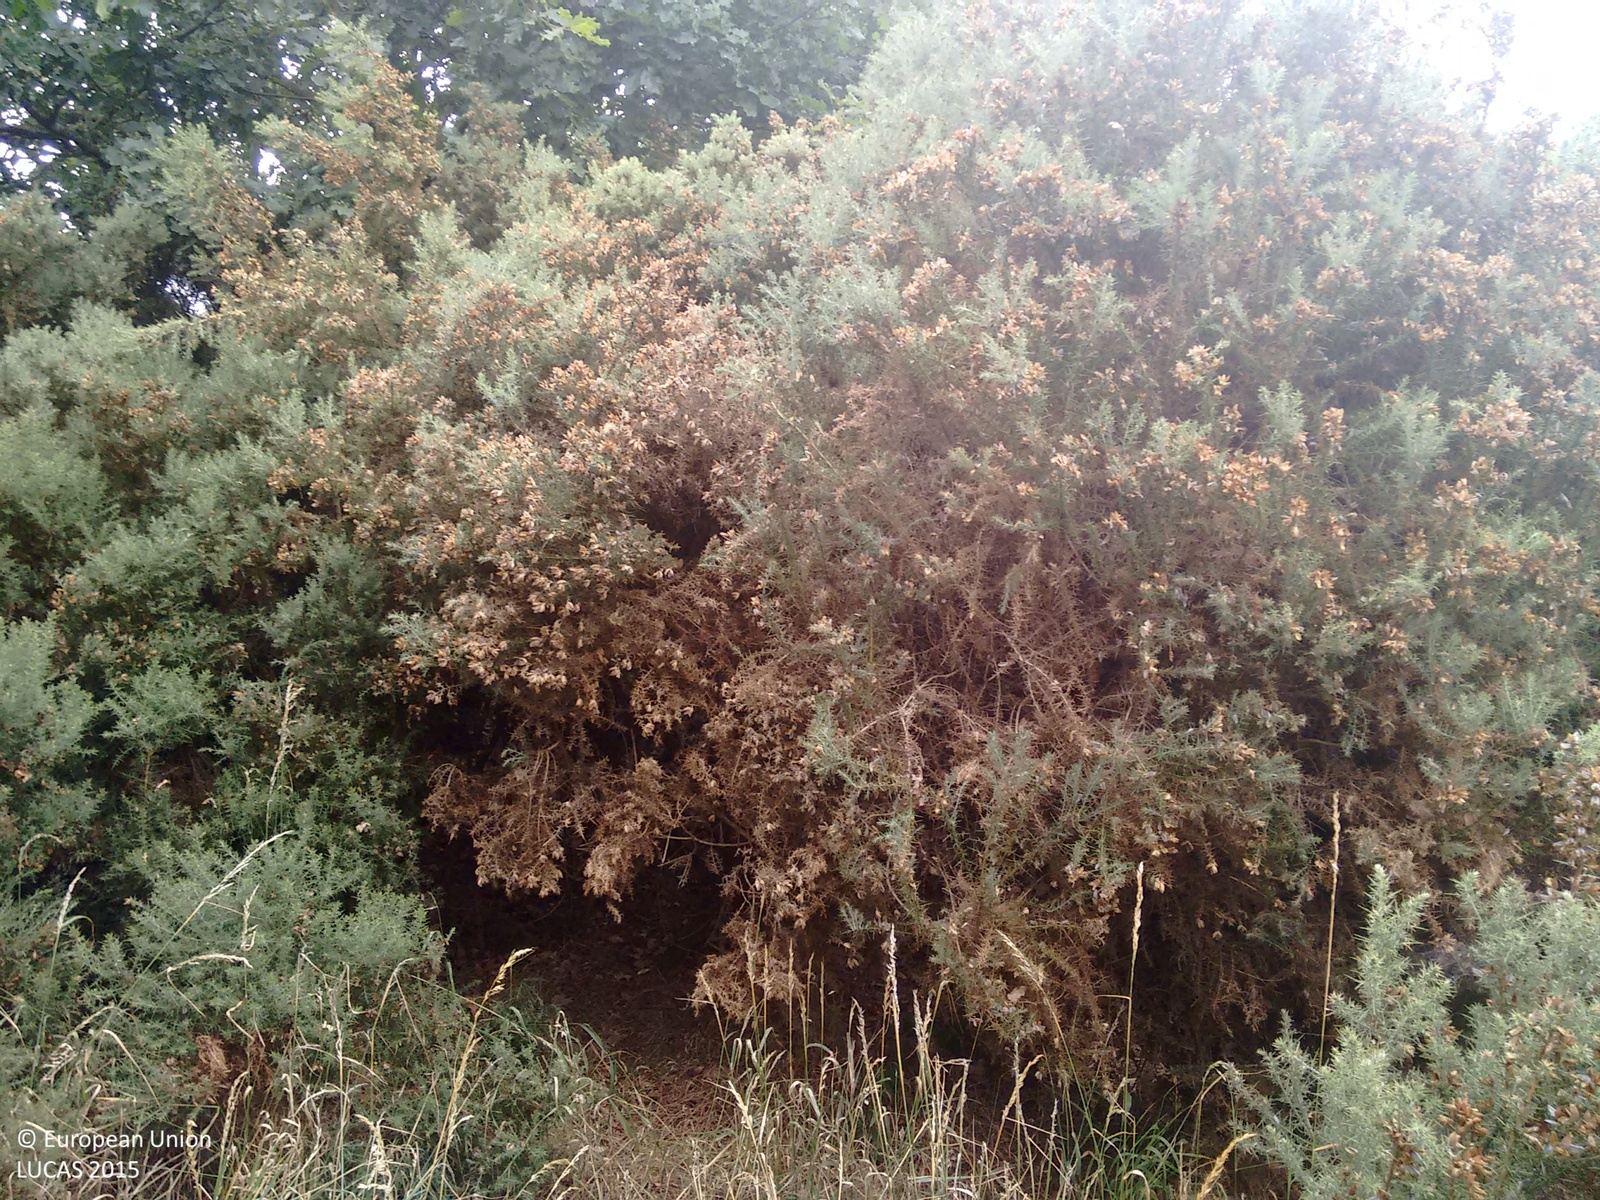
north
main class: Woodland
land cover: Broadleaved woodland
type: mesophytic deciduous forest
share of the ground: 50 - 75 %
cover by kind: broadleaved forest trees 50 %, shrubs 50 %
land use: Sport
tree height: > 5 m
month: July
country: GB
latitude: 51.4980
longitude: 0.3919
